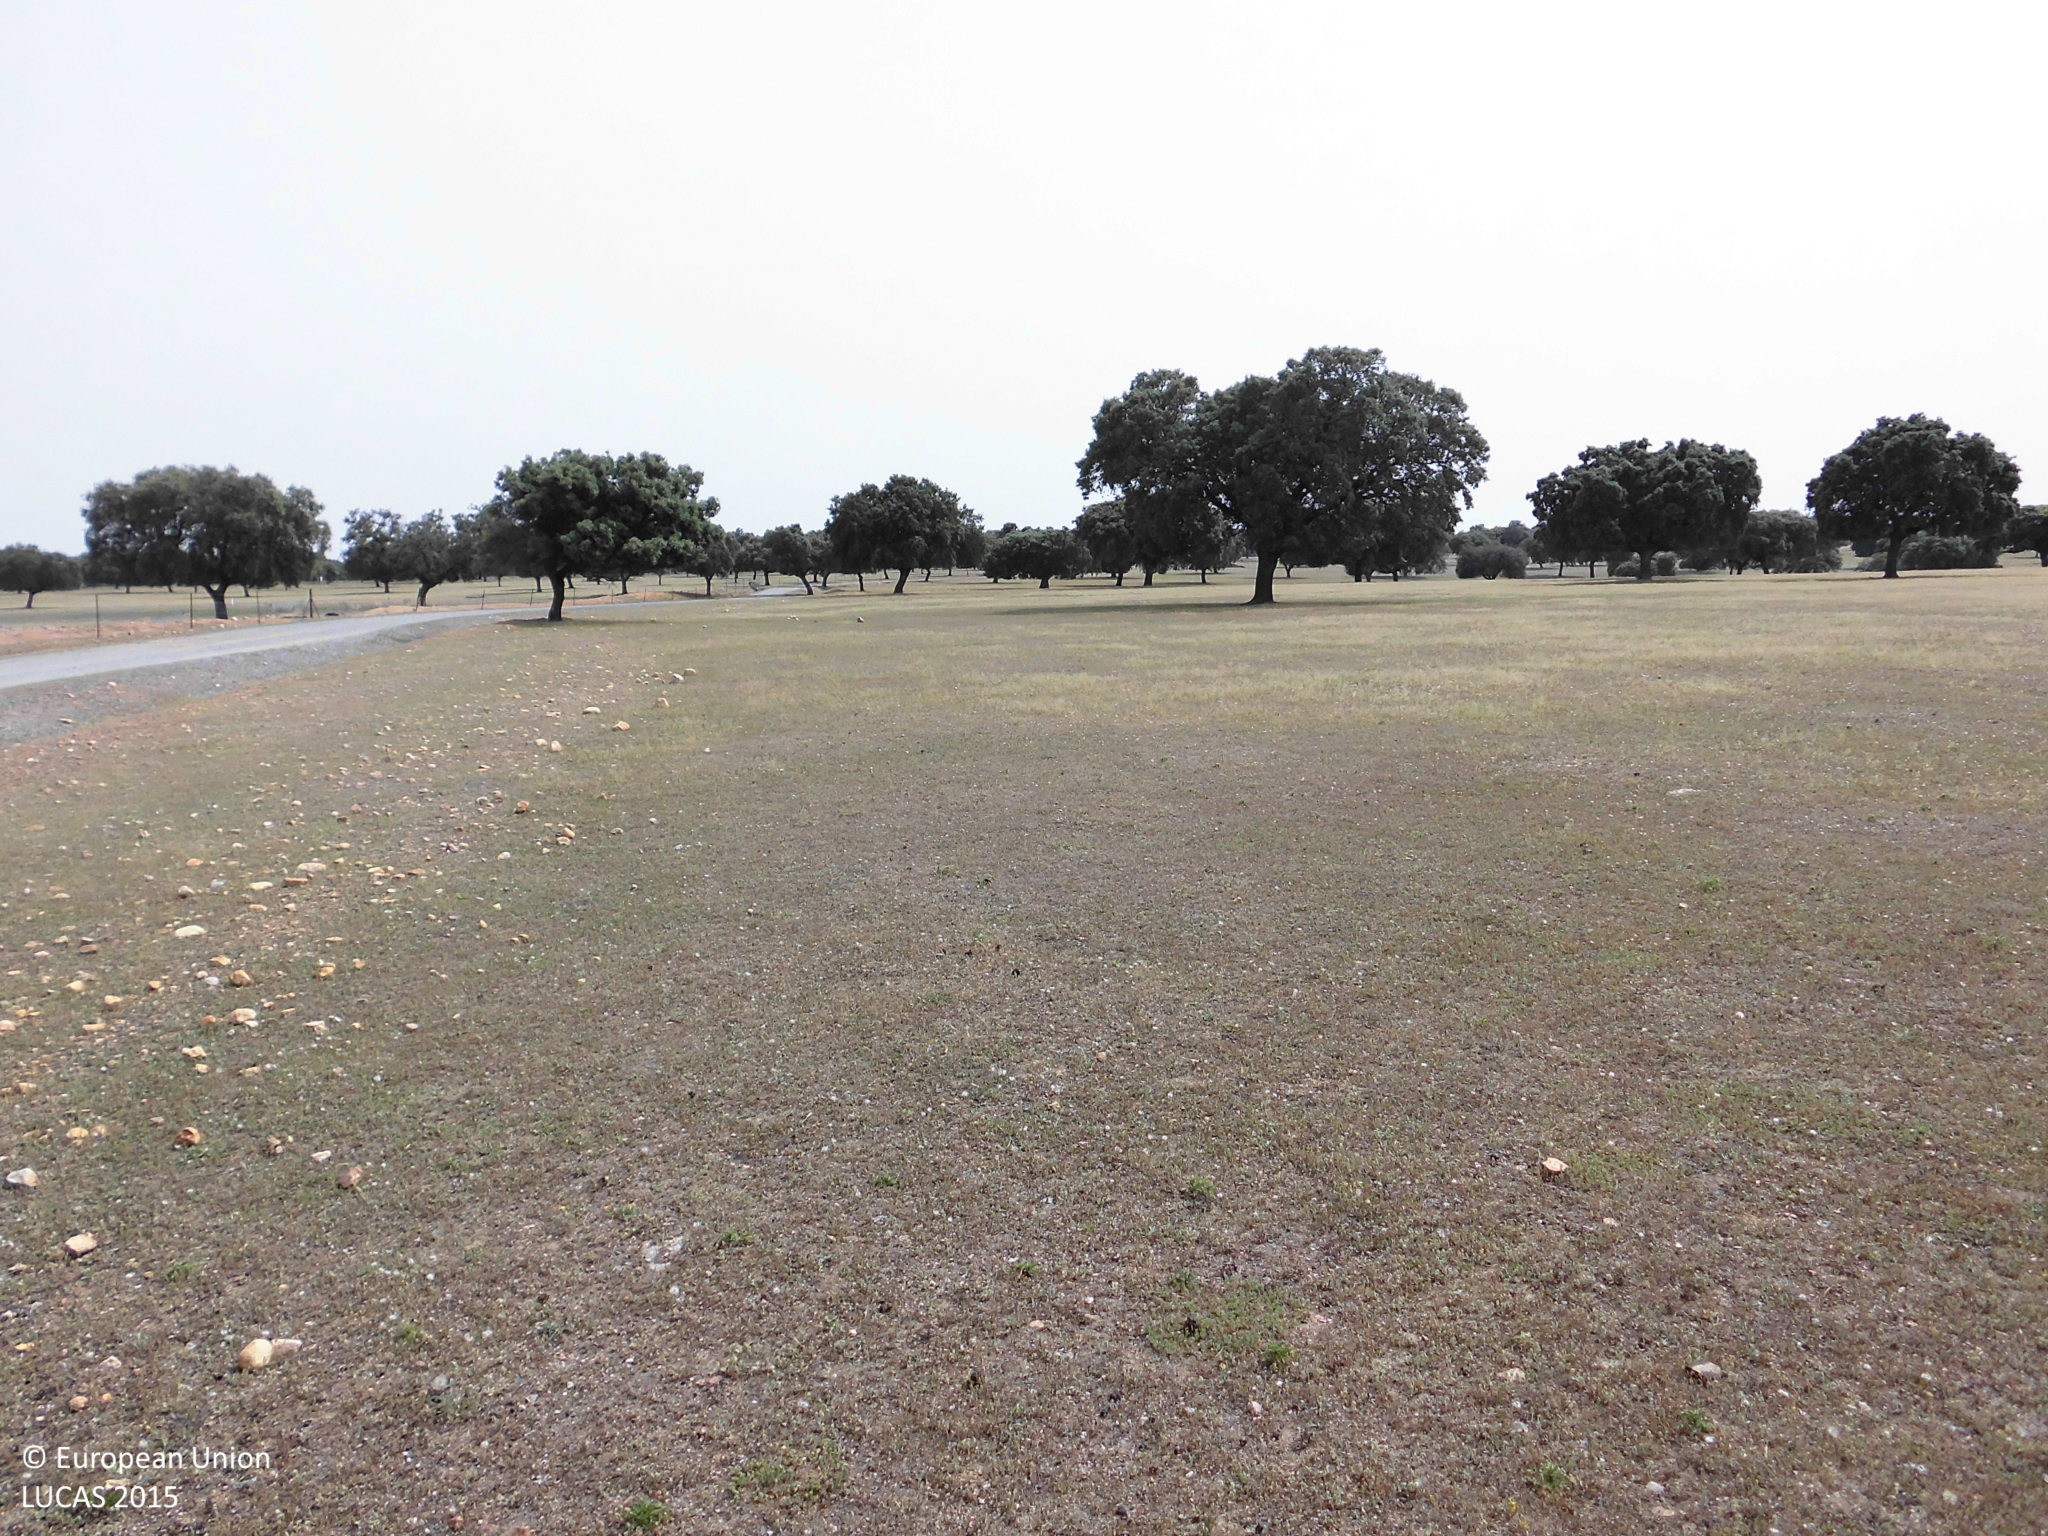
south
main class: Grassland
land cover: Grassland with sparse tree/shrub cover
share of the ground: > 75 %
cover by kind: herbaceous plants 65 %, consolidated bare surface 30 %, broadleaved forest trees 5 %
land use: Agriculture (excluding fallow land and kitchen gardens)
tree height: > 5 m
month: May
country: ES
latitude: 39.6928
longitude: -6.1480
